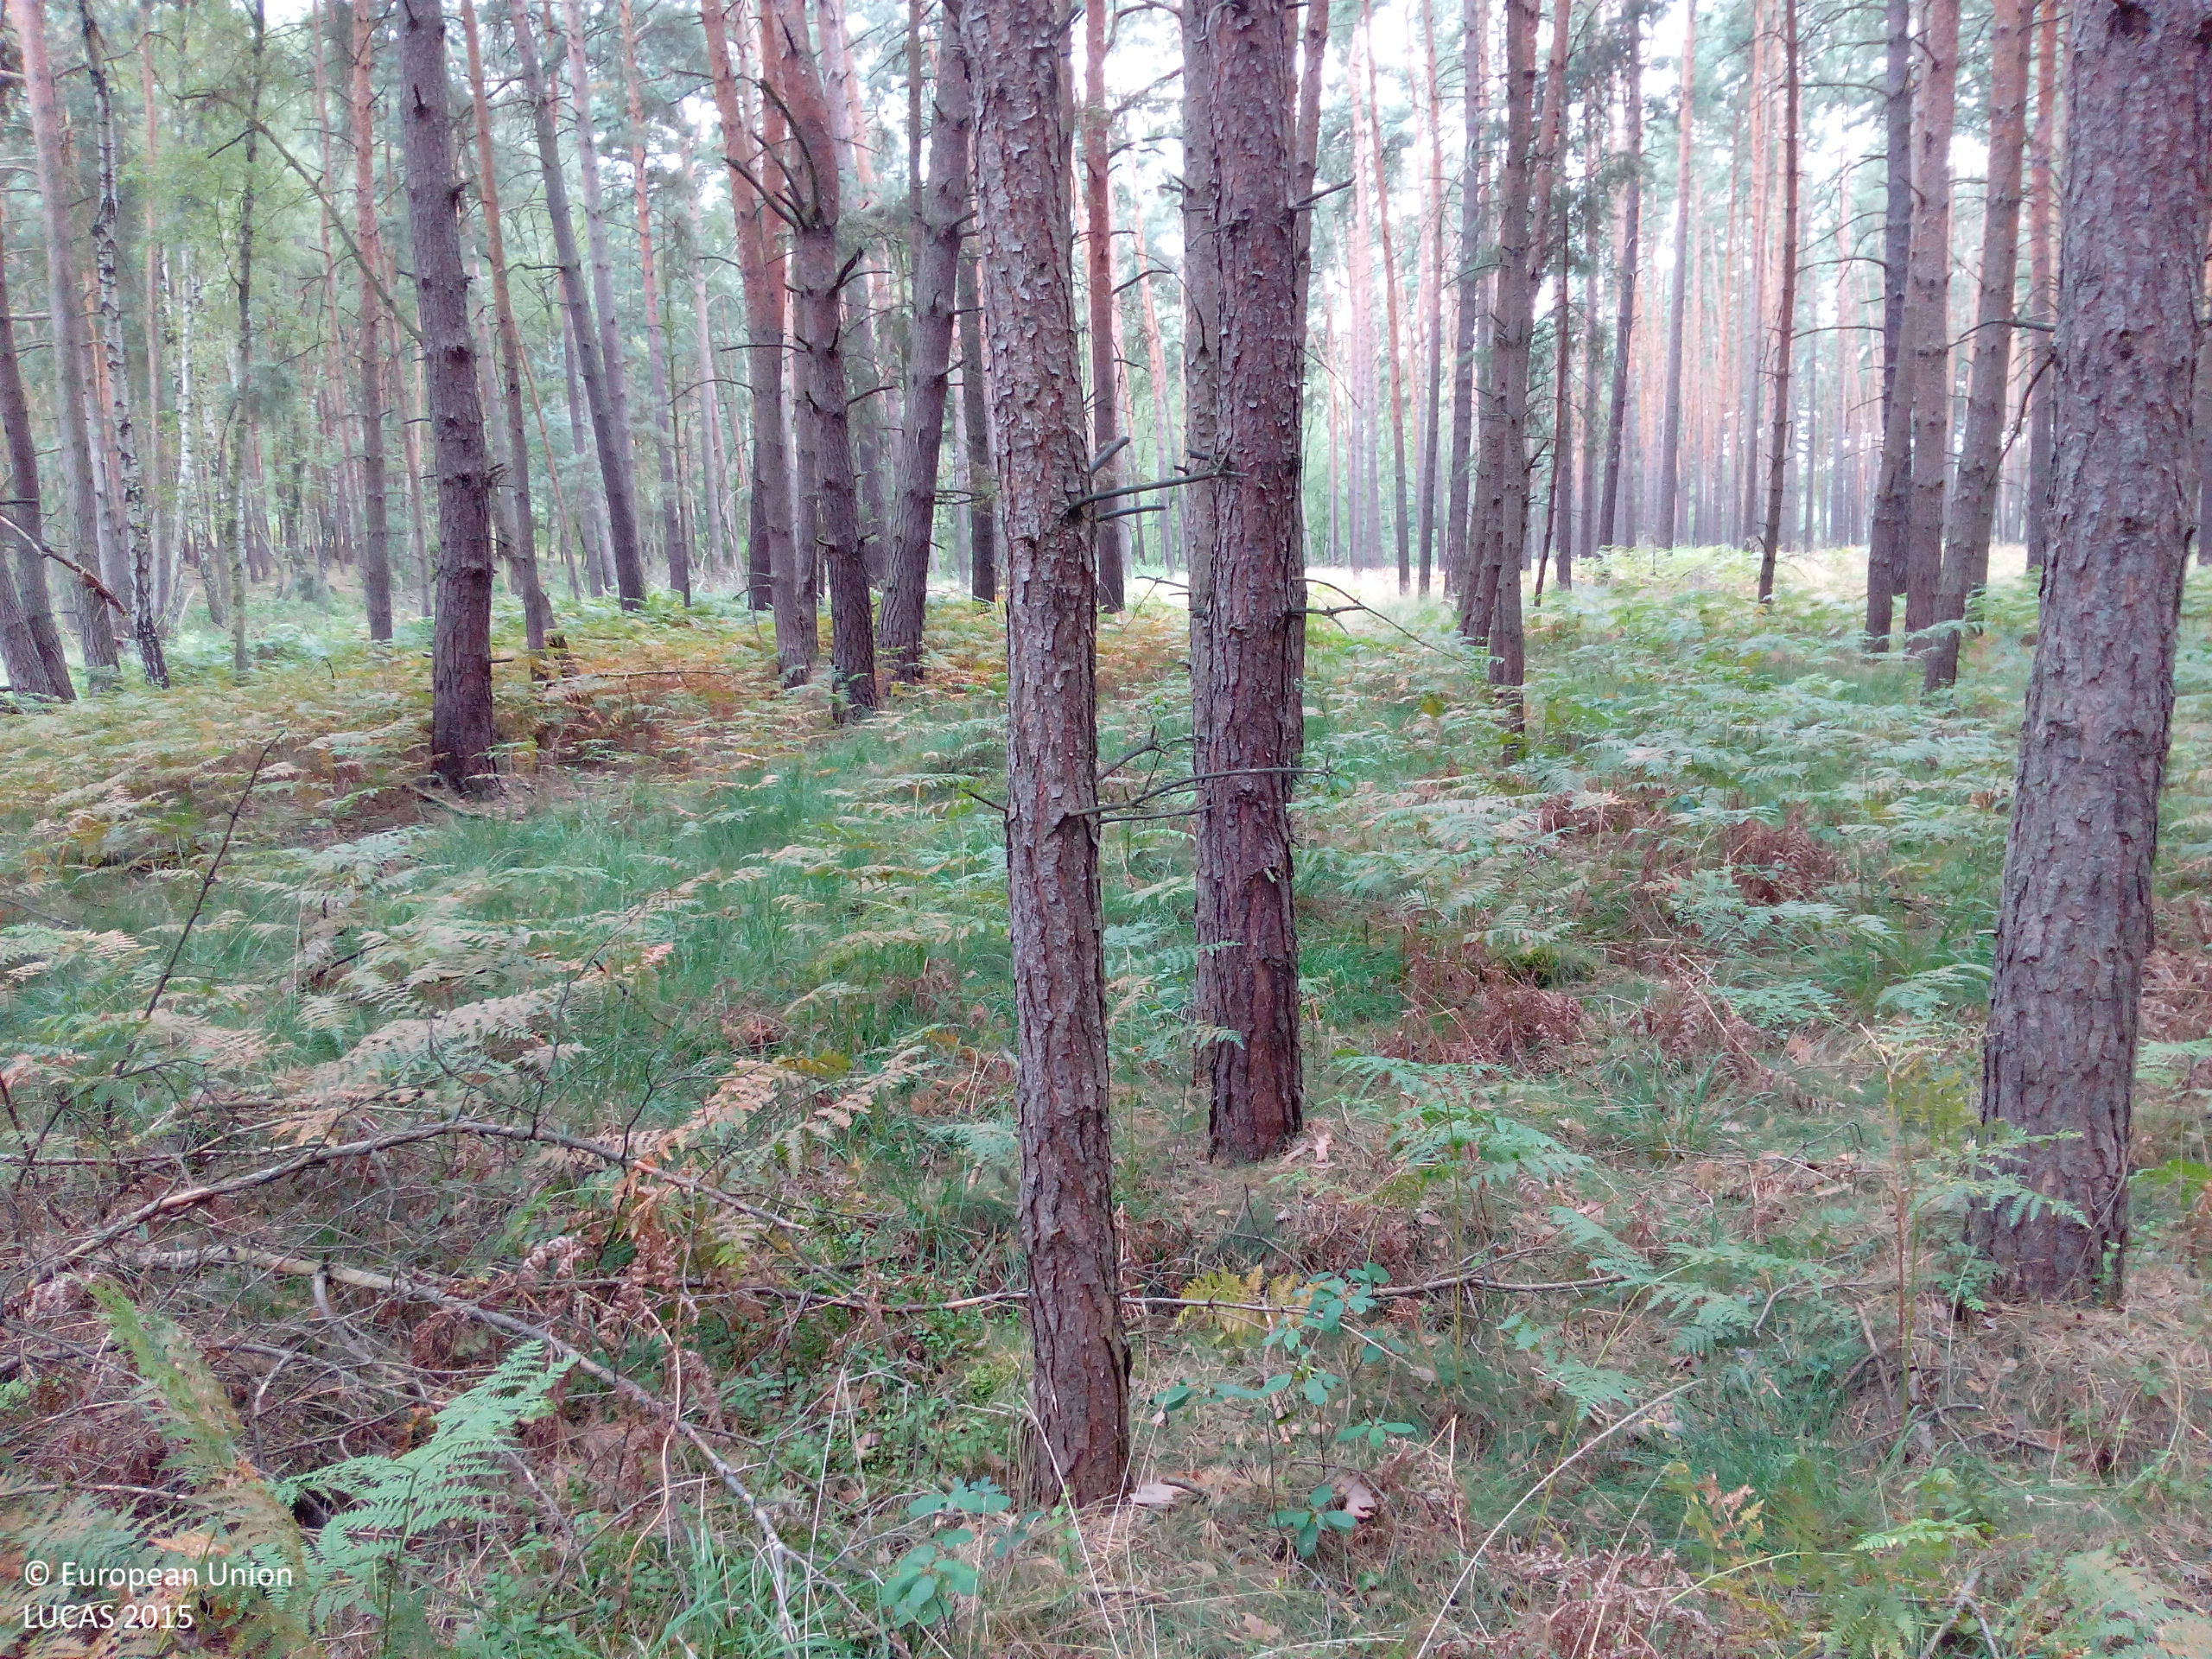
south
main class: Woodland
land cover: Pine dominated coniferous woodland
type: hemiboreal forest and nemoral coniferous forest and mixed broadleaved-coniferous forest
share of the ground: > 75 %
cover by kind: coniferous forest trees 100 %
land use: Forestry
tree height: > 5 m
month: August
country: DE
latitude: 51.9651
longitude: 14.0909
